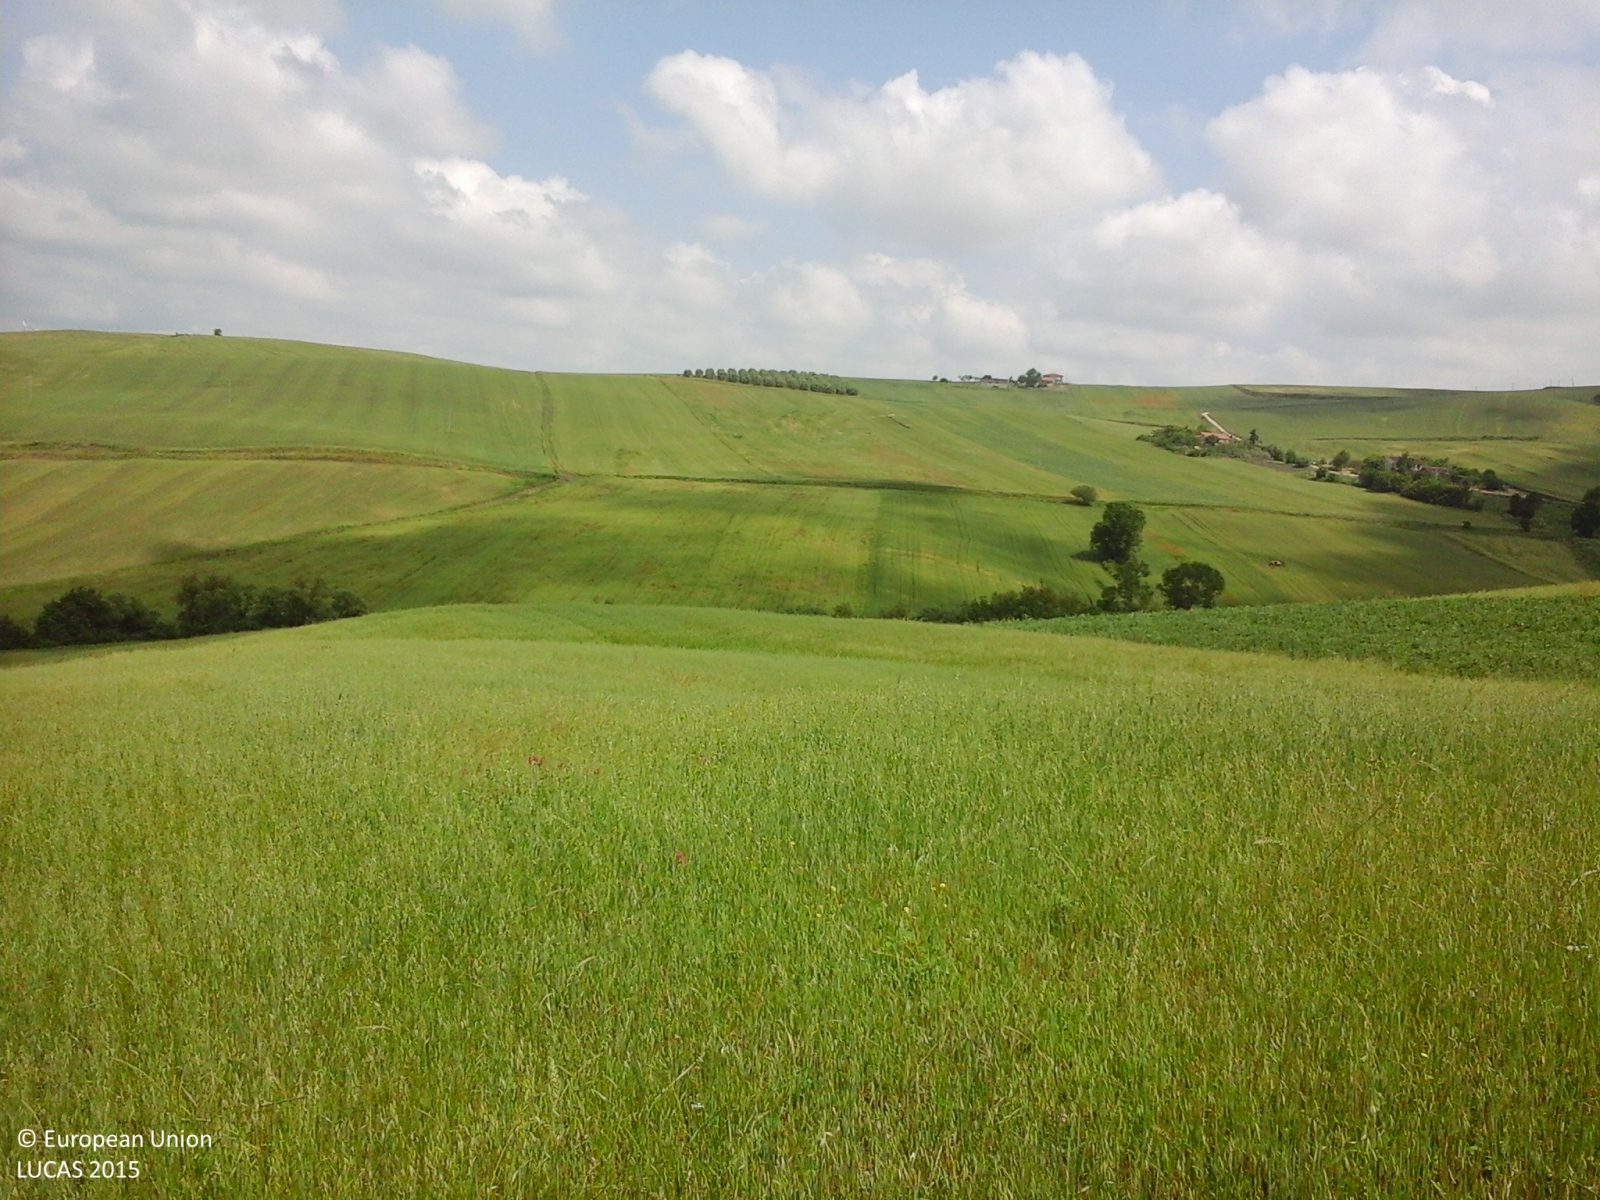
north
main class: Cropland
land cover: Oats
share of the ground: > 75 %
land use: Agriculture (excluding fallow land and kitchen gardens)
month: May
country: IT
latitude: 41.2221
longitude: 15.0990
